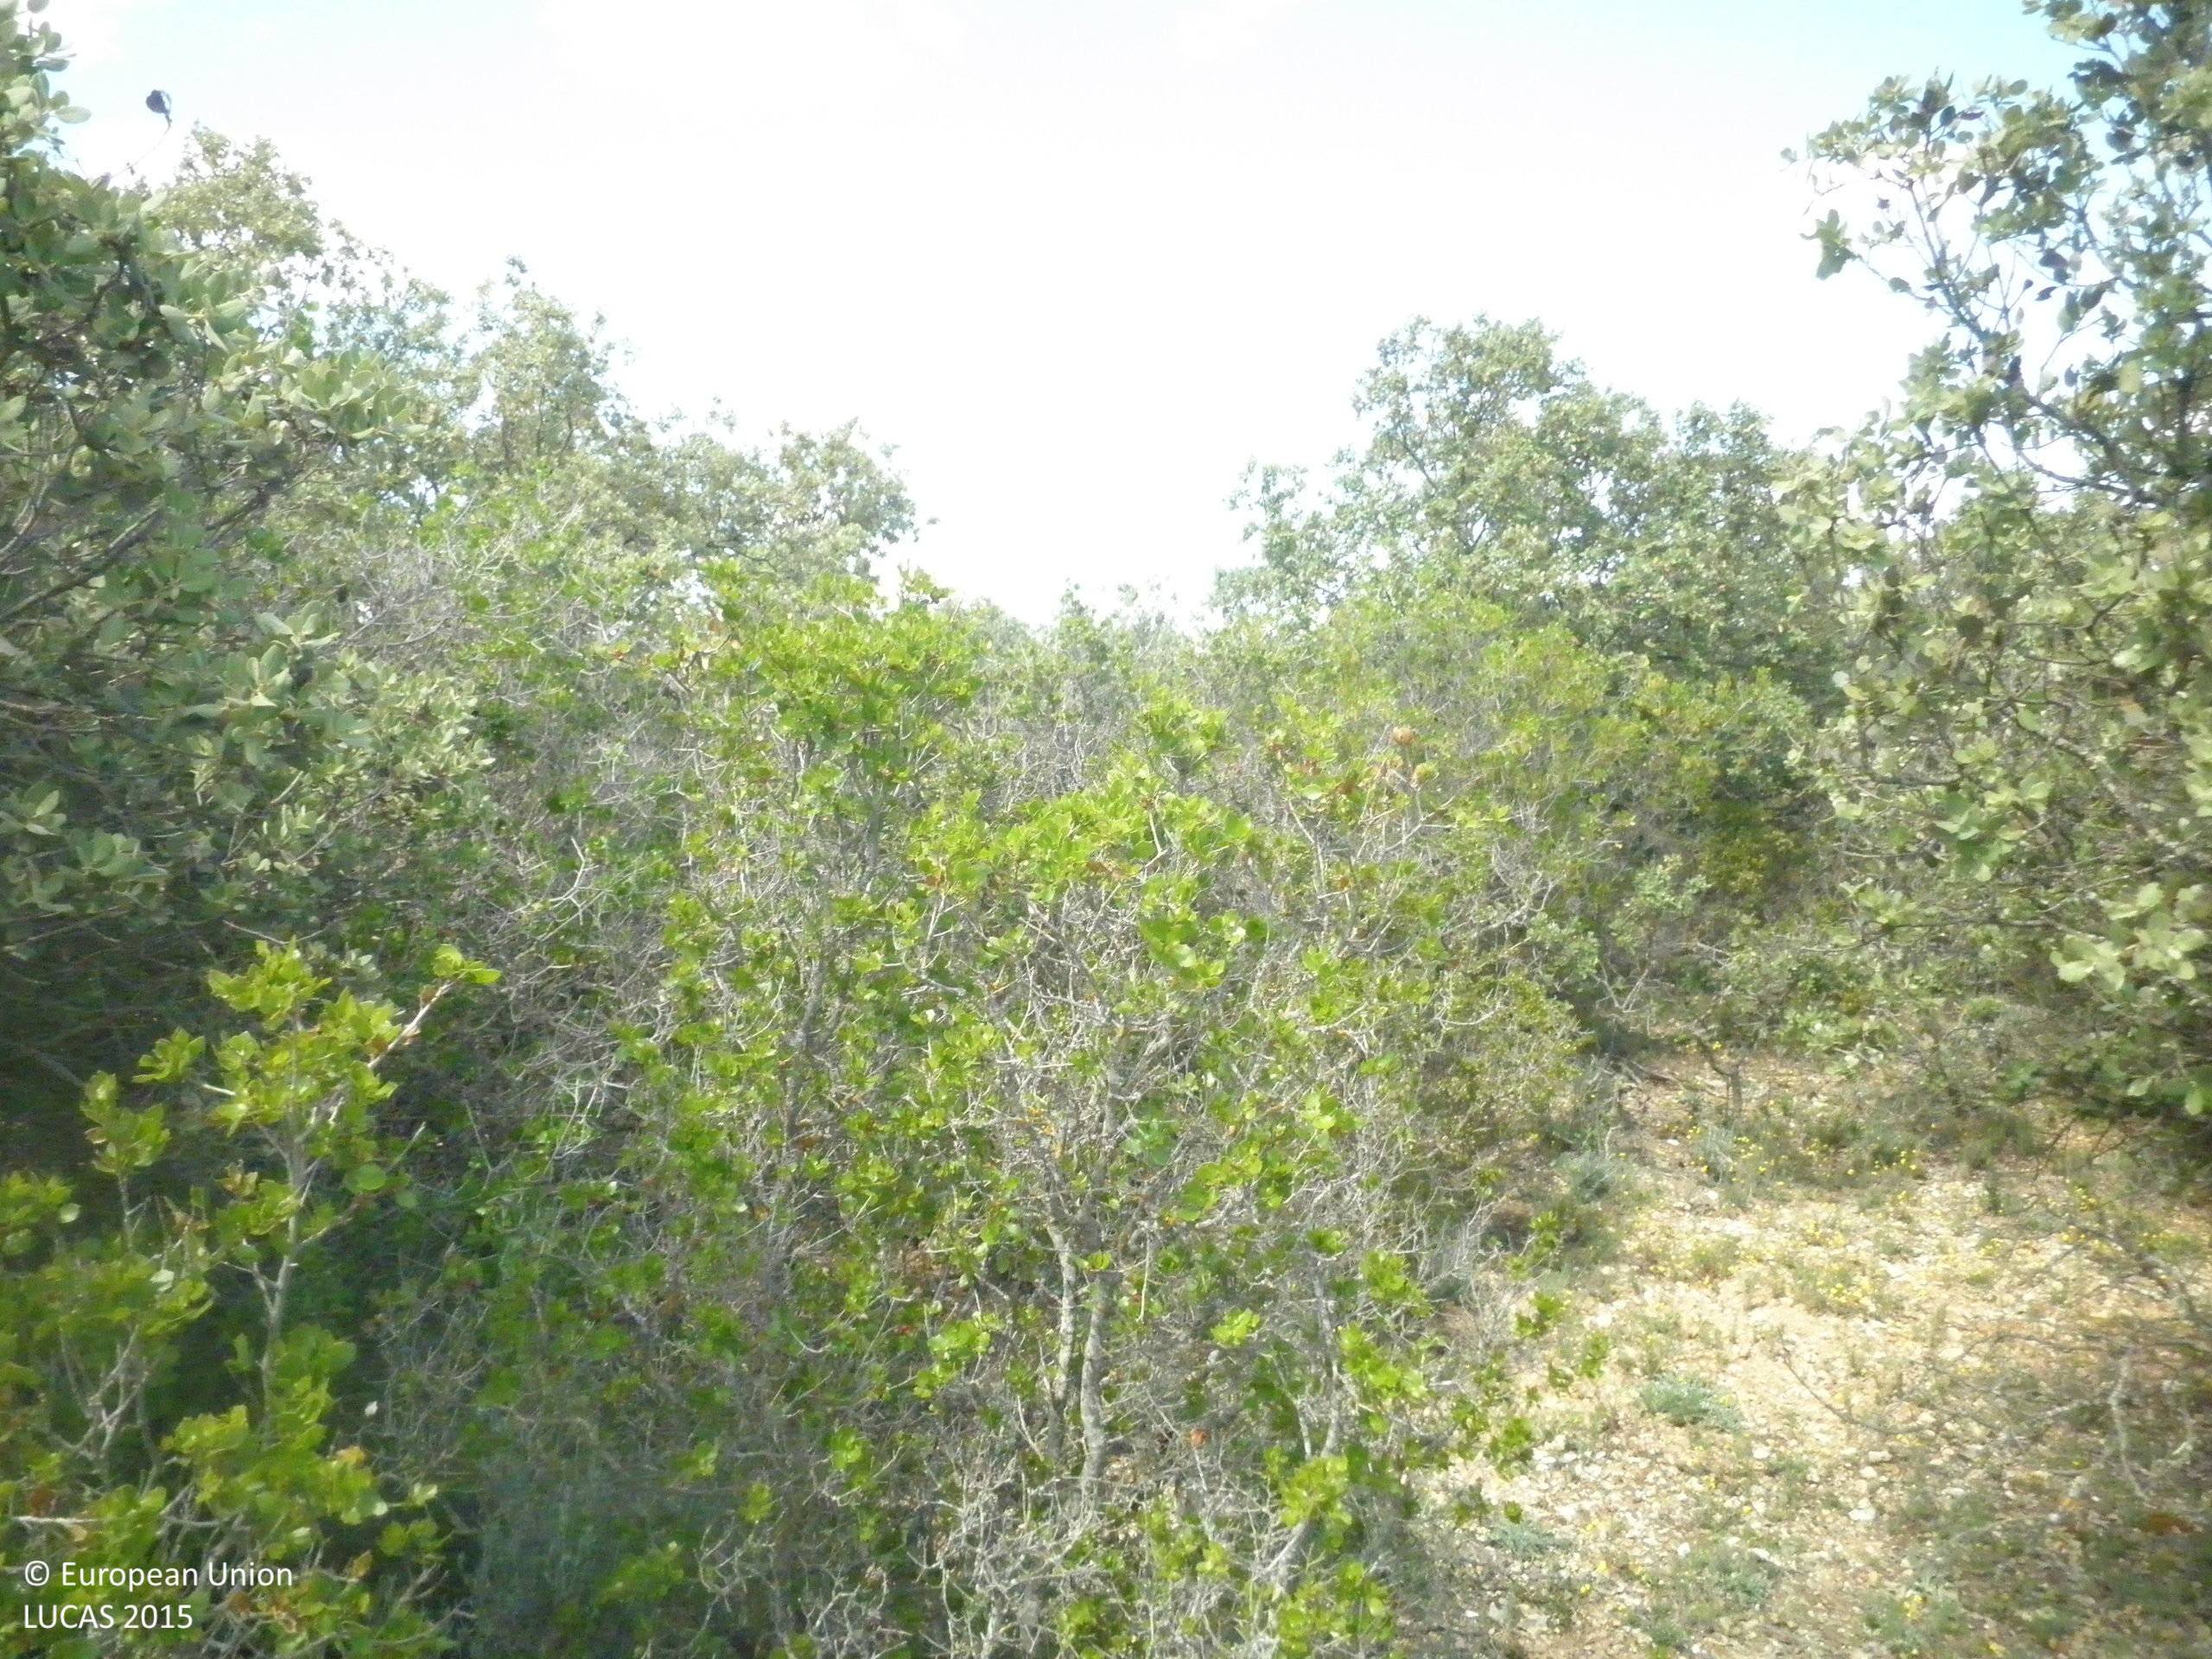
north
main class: Woodland
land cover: Broadleaved woodland
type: broadleaved evergreen forest
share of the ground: 25 - 50 %
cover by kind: shrubs 30 %, broadleaved forest trees 25 %, herbaceous plants 15 %, consolidated bare surface 15 %, unconsolidated bare surface 15 %
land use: Semi-natural and natural areas not in use
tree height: < 5 m
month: May
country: ES
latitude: 39.6594
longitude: -2.8269
